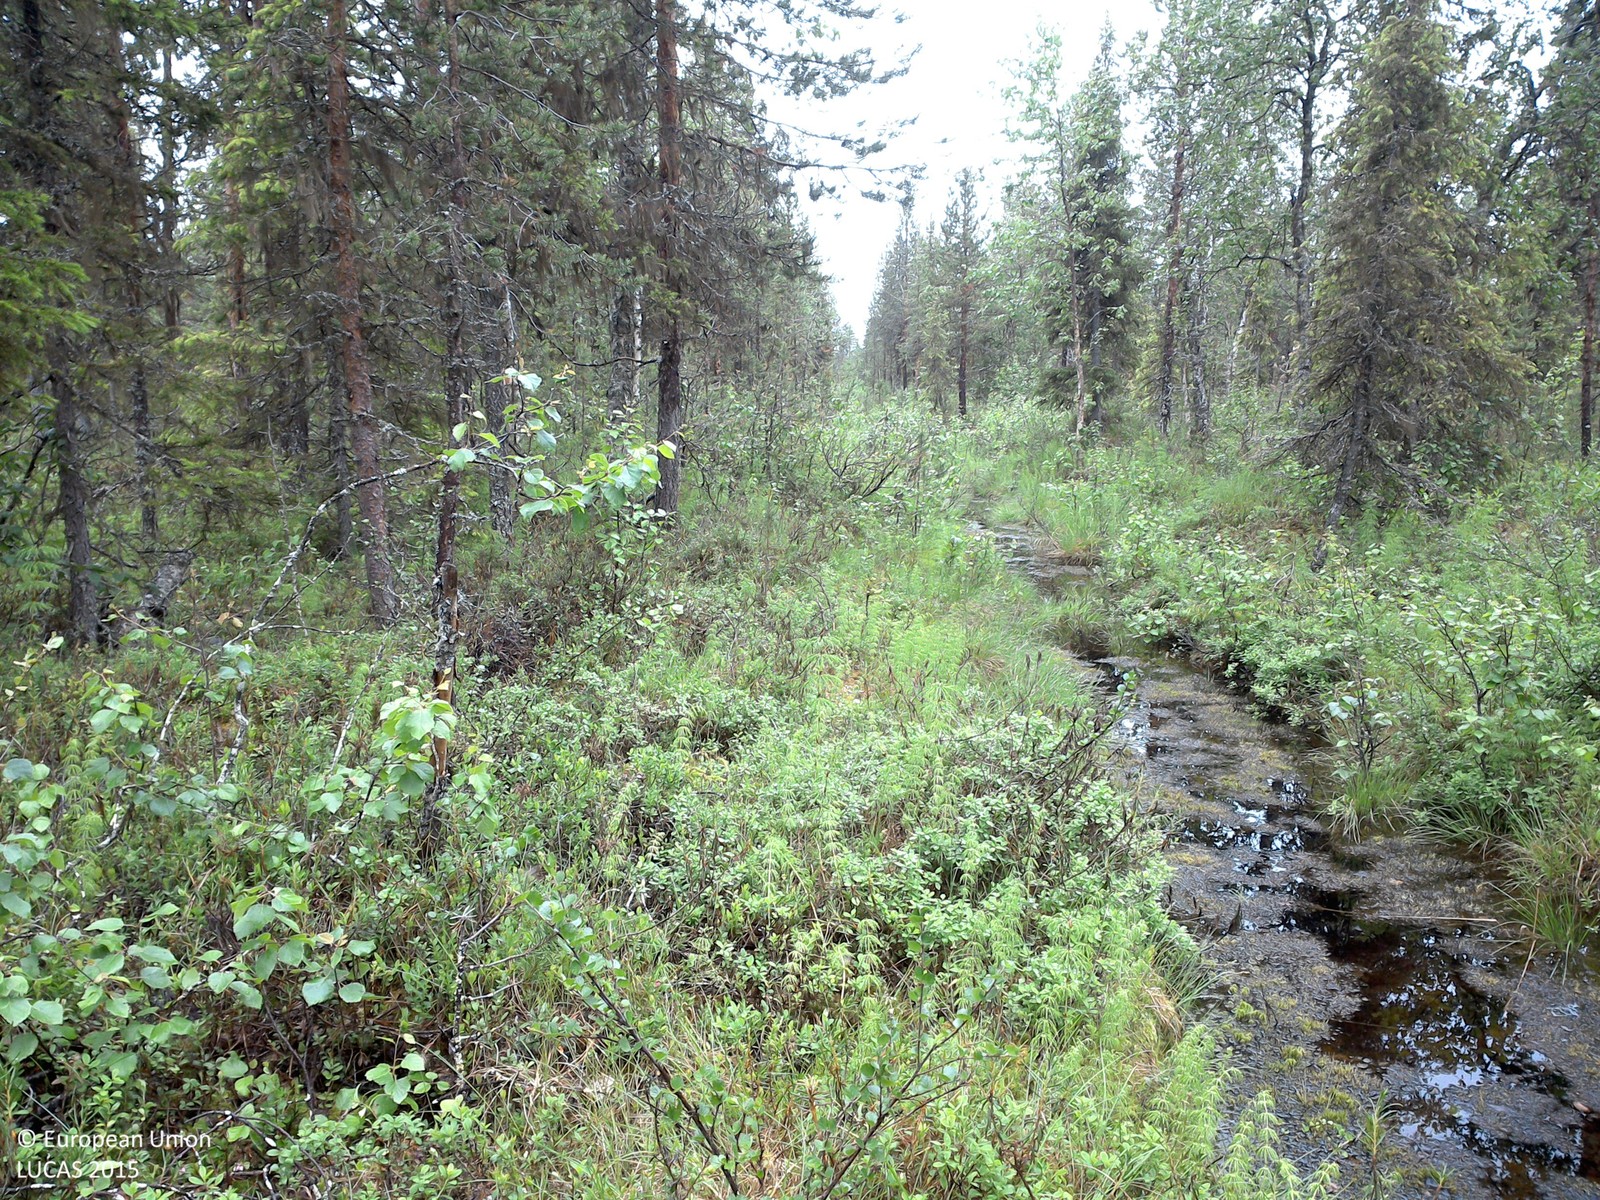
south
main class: Woodland
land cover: Pine dominated mixed woodland
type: boreal forest
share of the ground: 25 - 50 %
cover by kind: shrubs 55 %, coniferous forest trees 20 %, broadleaved forest trees 10 %, herbaceous plants 10 %, lichens and mosses 5 %
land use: Forestry
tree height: > 5 m
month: July
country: SE
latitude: 67.1029
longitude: 23.6350
